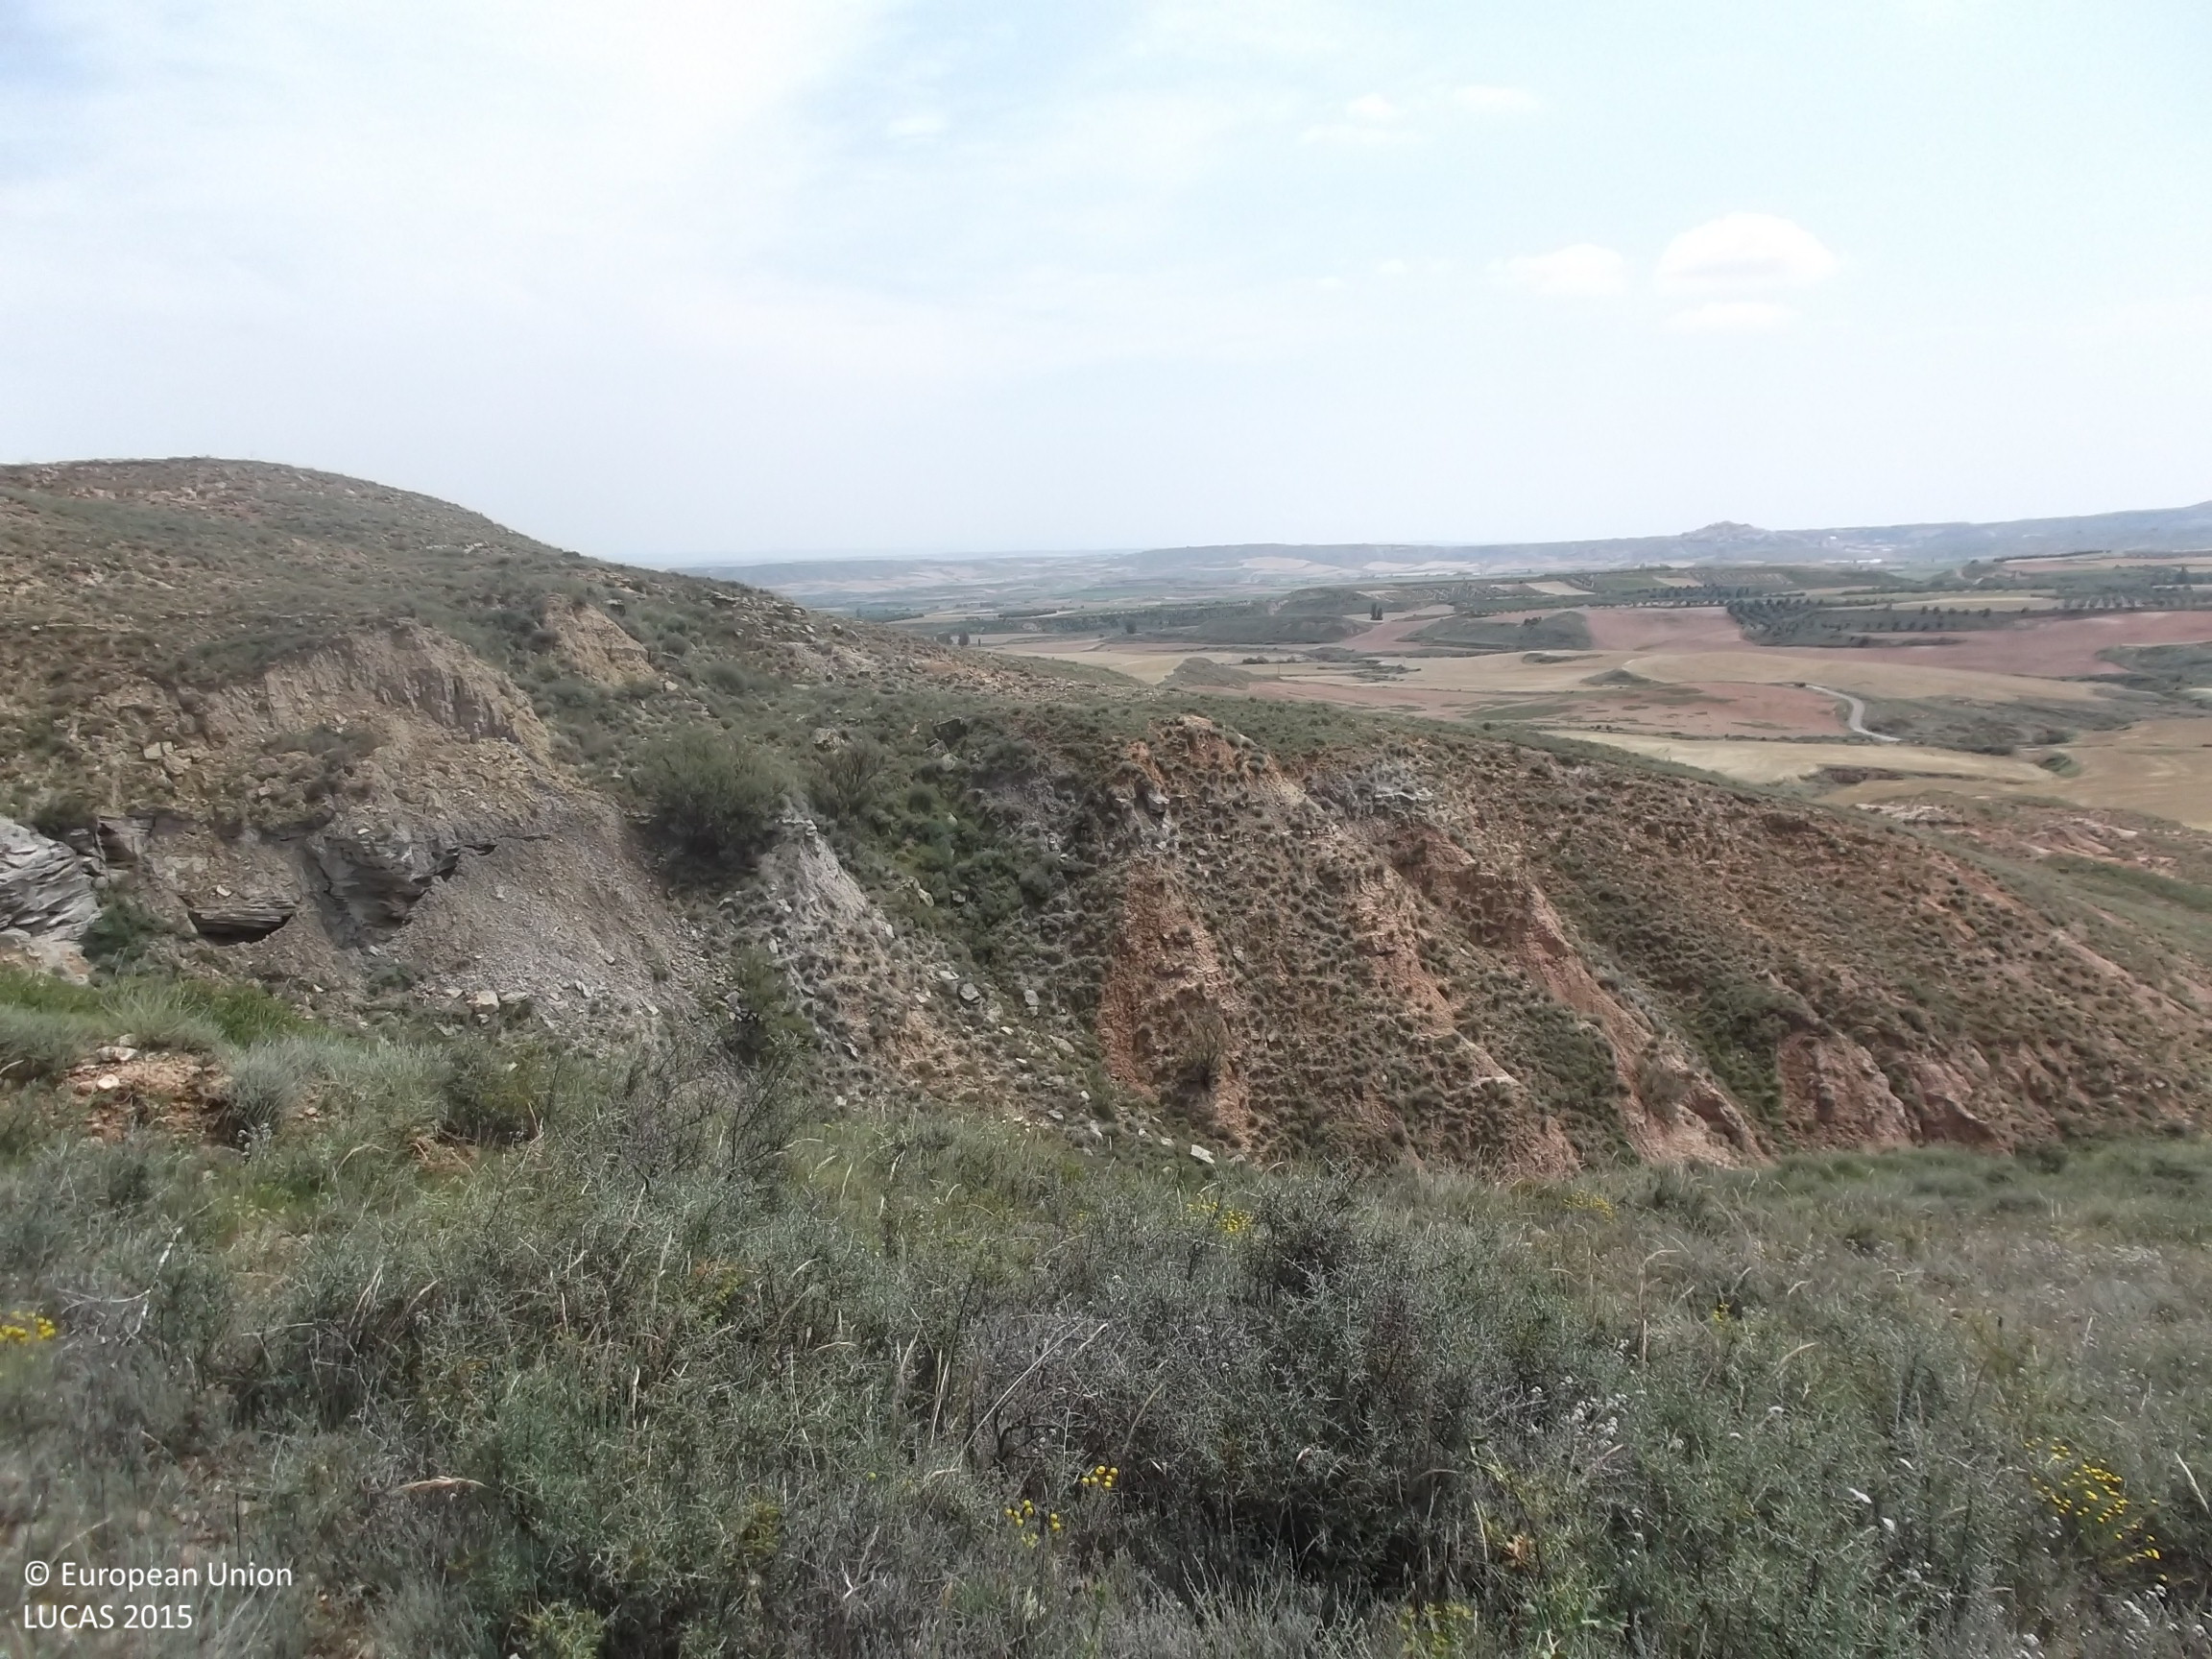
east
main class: Shrubland
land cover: Shrubland without tree cover
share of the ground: > 75 %
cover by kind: shrubs 75 %, unconsolidated bare surface 15 %, herbaceous plants 5 %
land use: Semi-natural and natural areas not in use
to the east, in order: Shrubland without tree cover
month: June
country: ES
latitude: 42.3642
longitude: -2.2444
